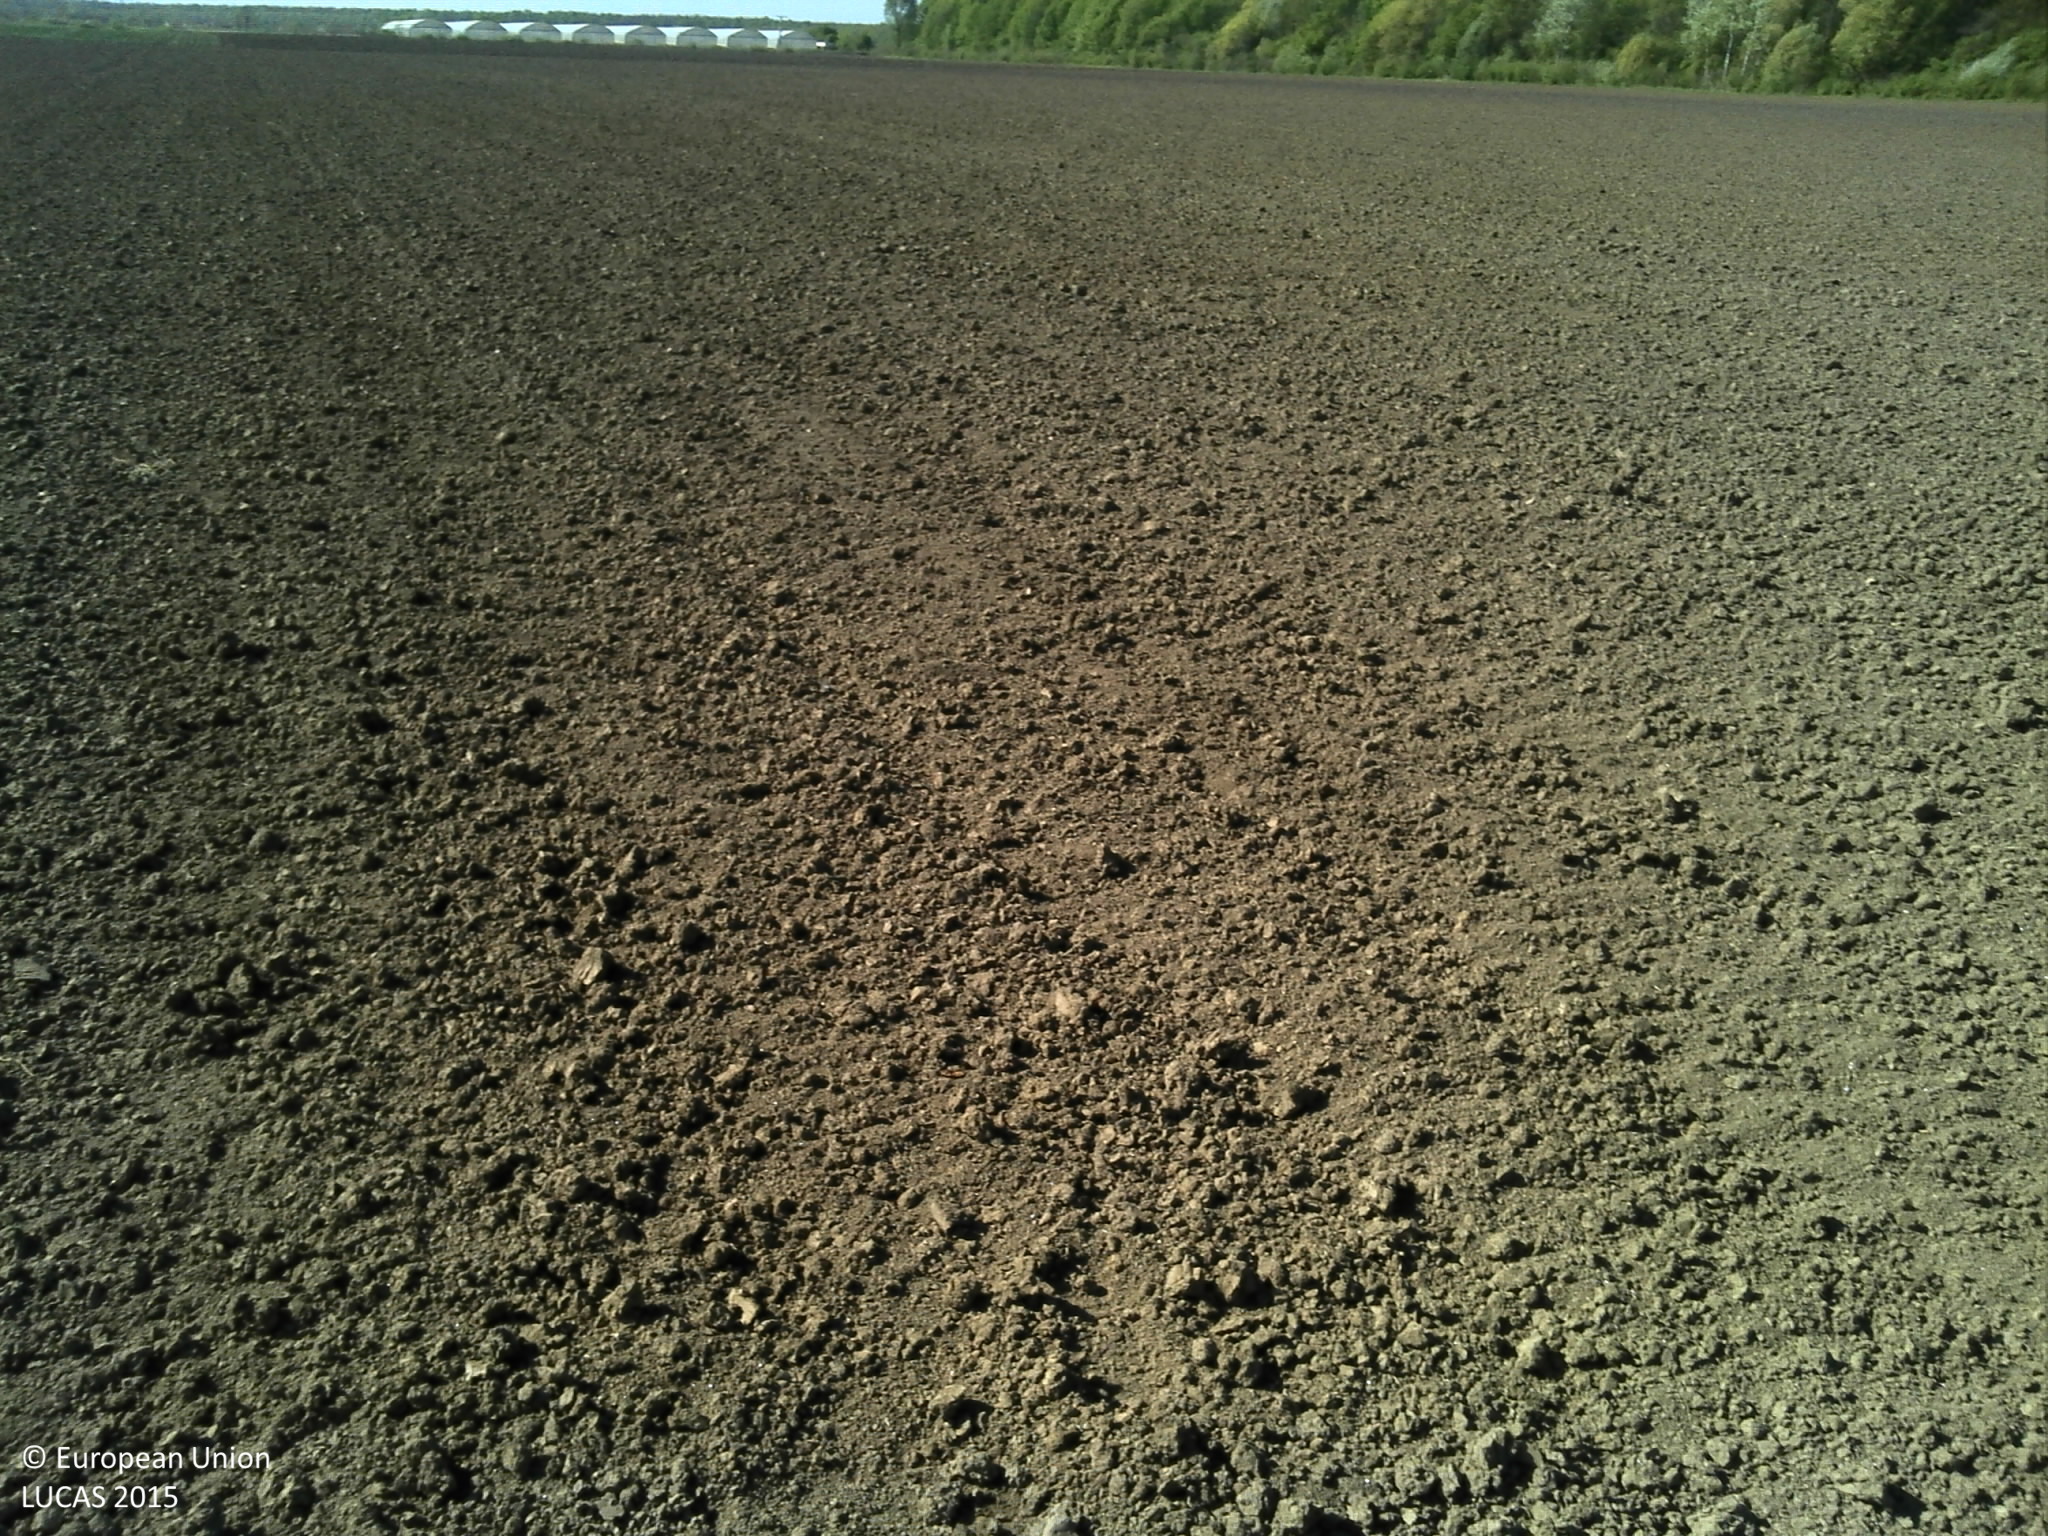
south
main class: Cropland
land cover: Soya
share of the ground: < 10 %
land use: Agriculture (excluding fallow land and kitchen gardens)
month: April
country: HR
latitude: 45.2253
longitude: 18.6025
